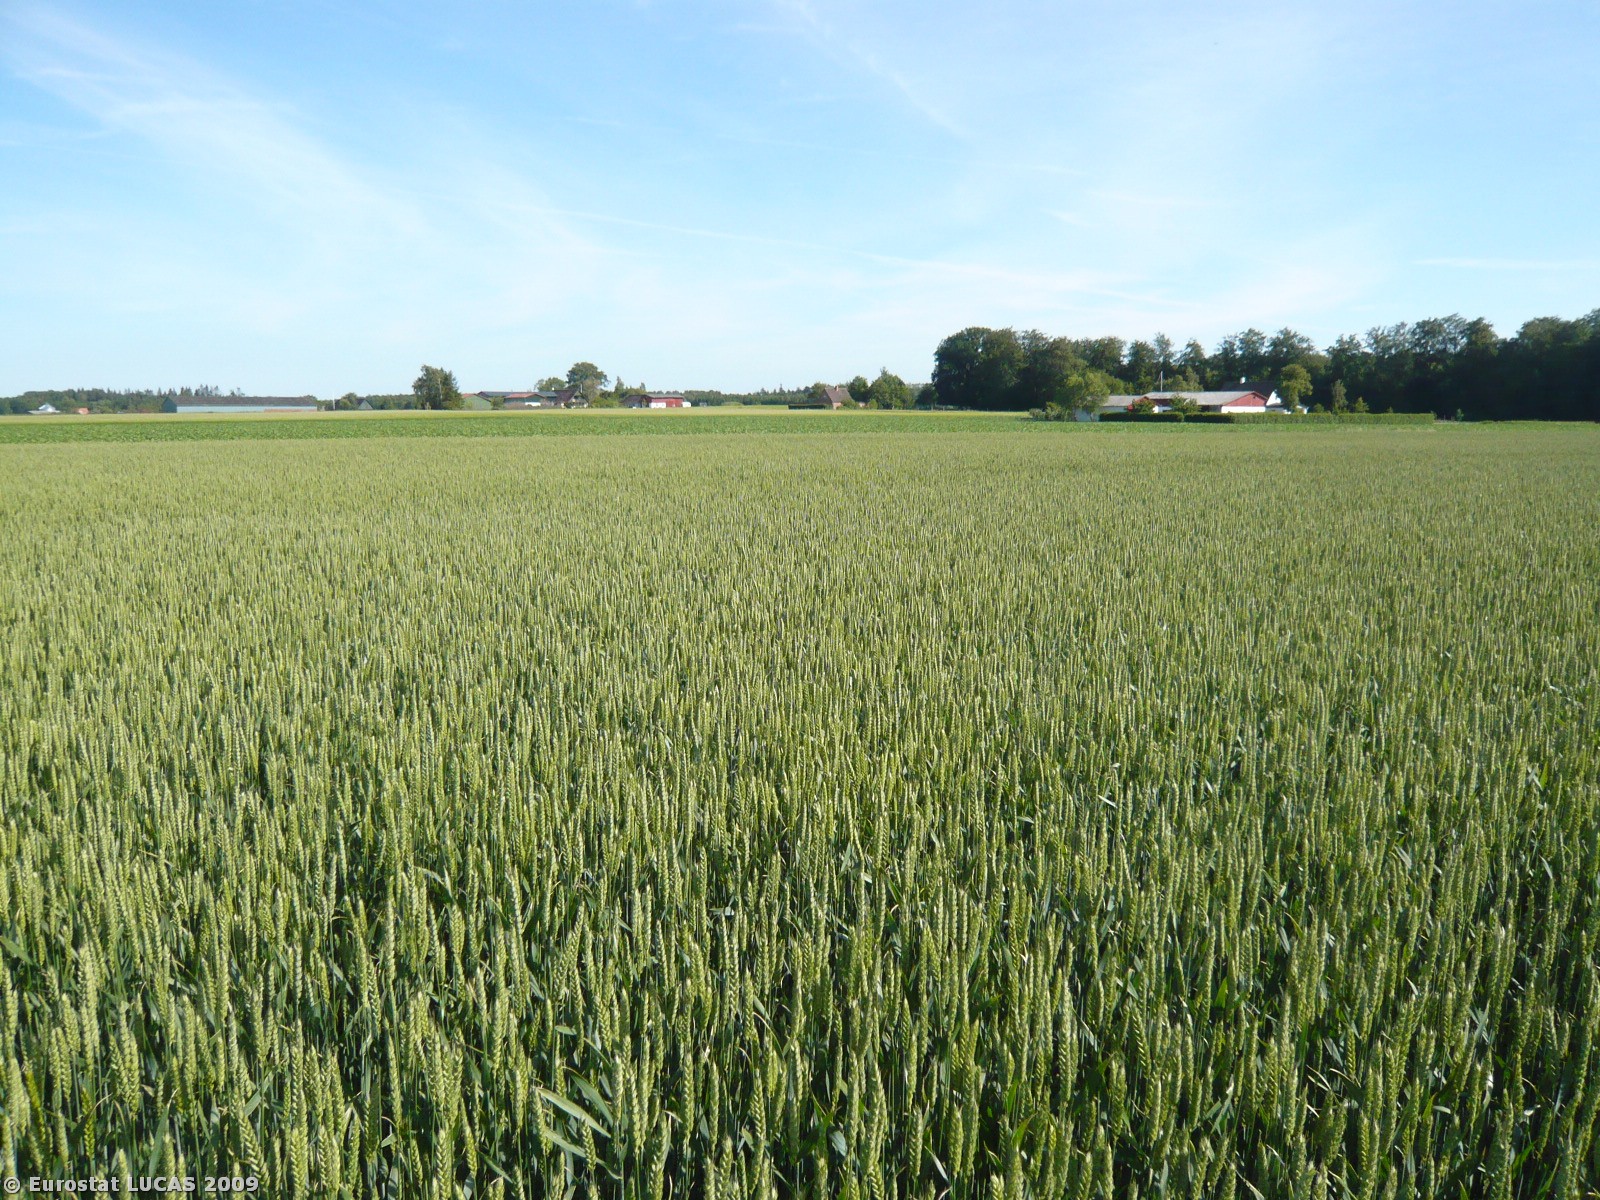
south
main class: Cropland
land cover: Common wheat
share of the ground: > 75 %
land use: Agriculture (excluding fallow land and kitchen gardens)
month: June
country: DK
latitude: 54.7964
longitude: 11.3523
